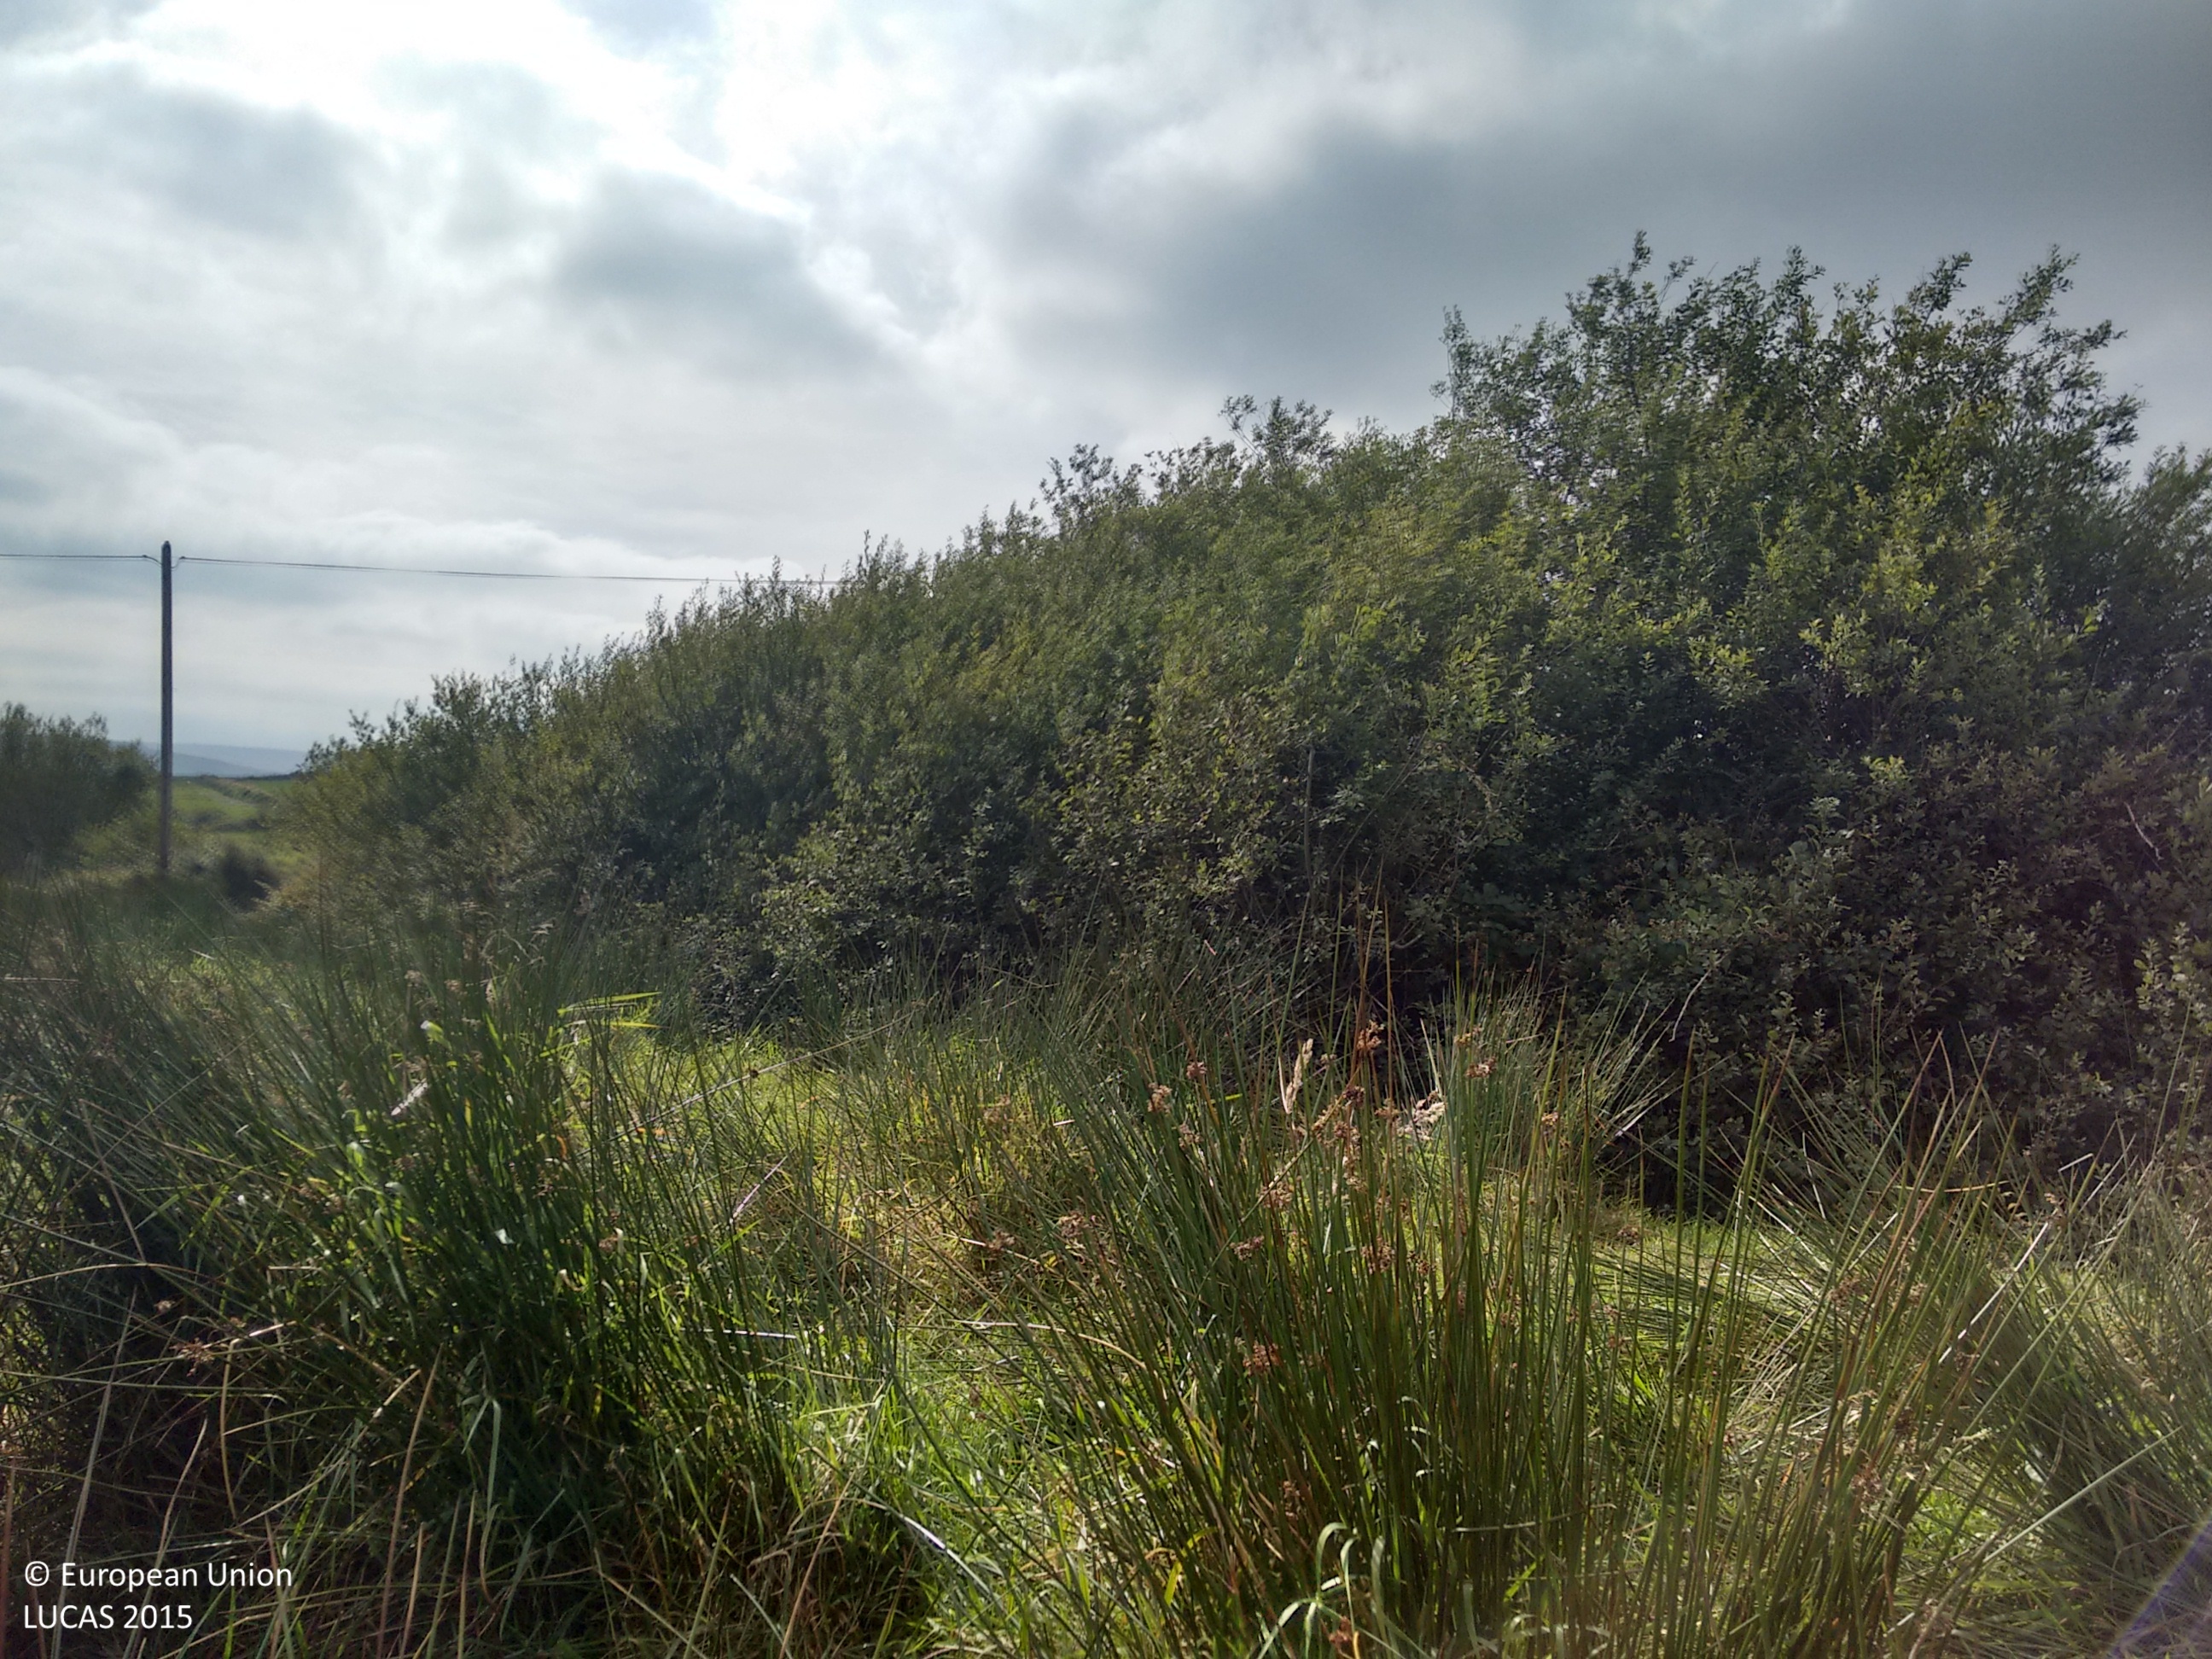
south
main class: Grassland
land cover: Grassland without tree/shrub cover
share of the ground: > 75 %
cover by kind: herbaceous plants 95 %, shrubs 5 %
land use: Agriculture (excluding fallow land and kitchen gardens)
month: September
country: IE
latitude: 52.3916
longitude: -9.1301
